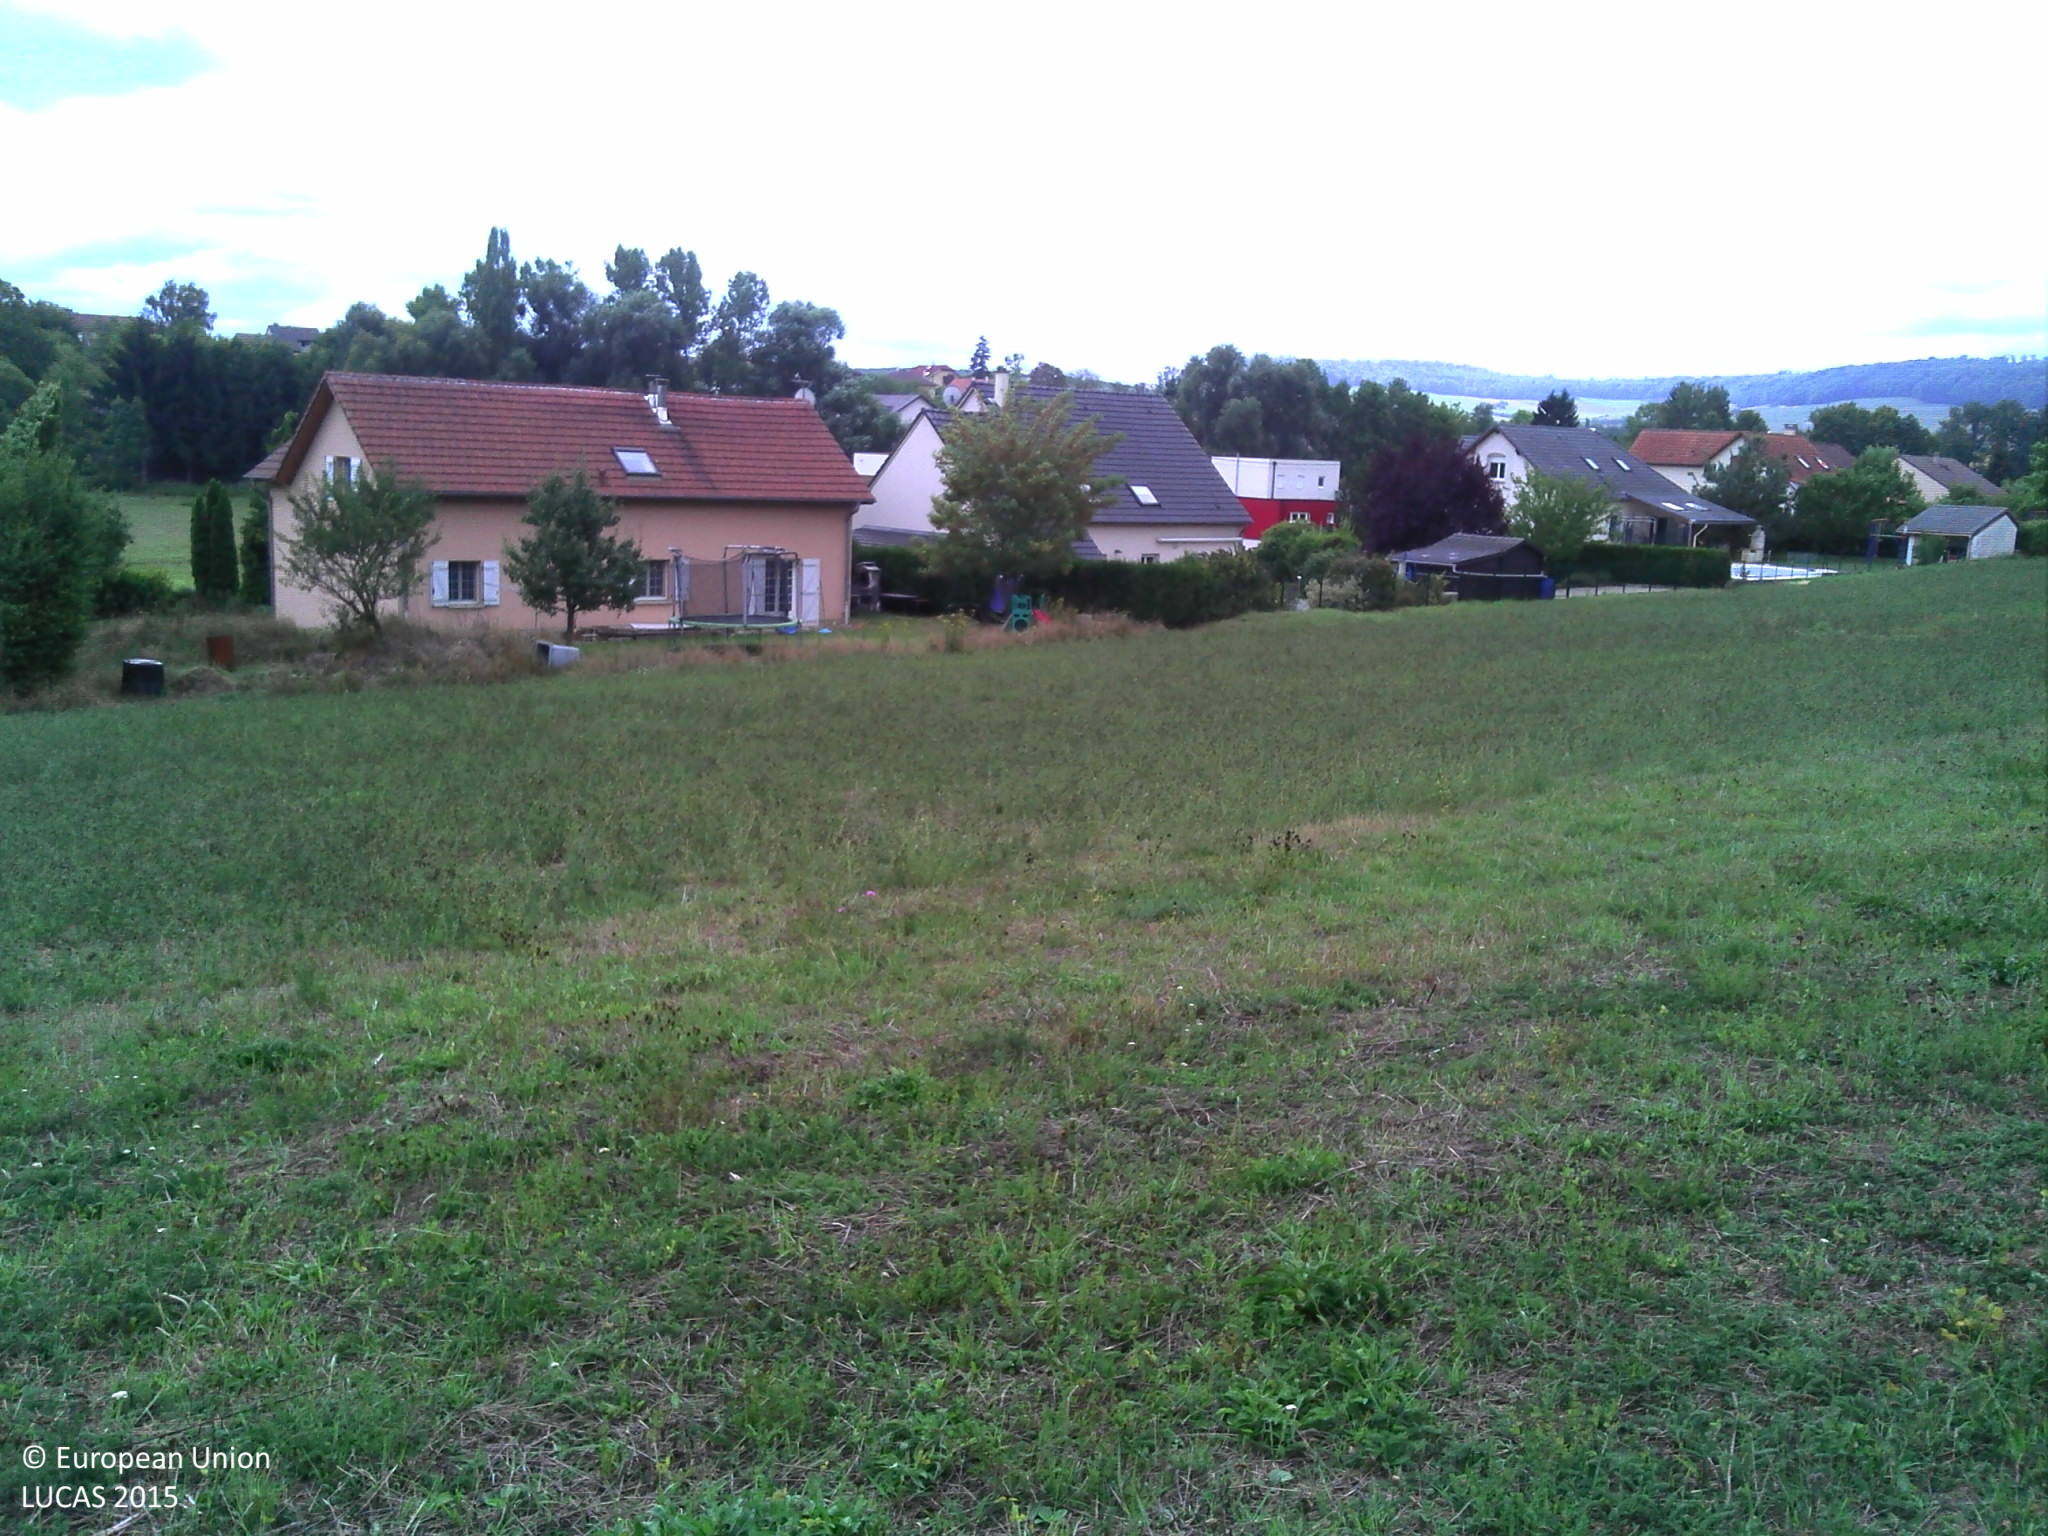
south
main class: Cropland
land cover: Temporary grasslands
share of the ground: > 75 %
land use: Agriculture (excluding fallow land and kitchen gardens)
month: September
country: FR
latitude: 48.5853
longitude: 6.0550
